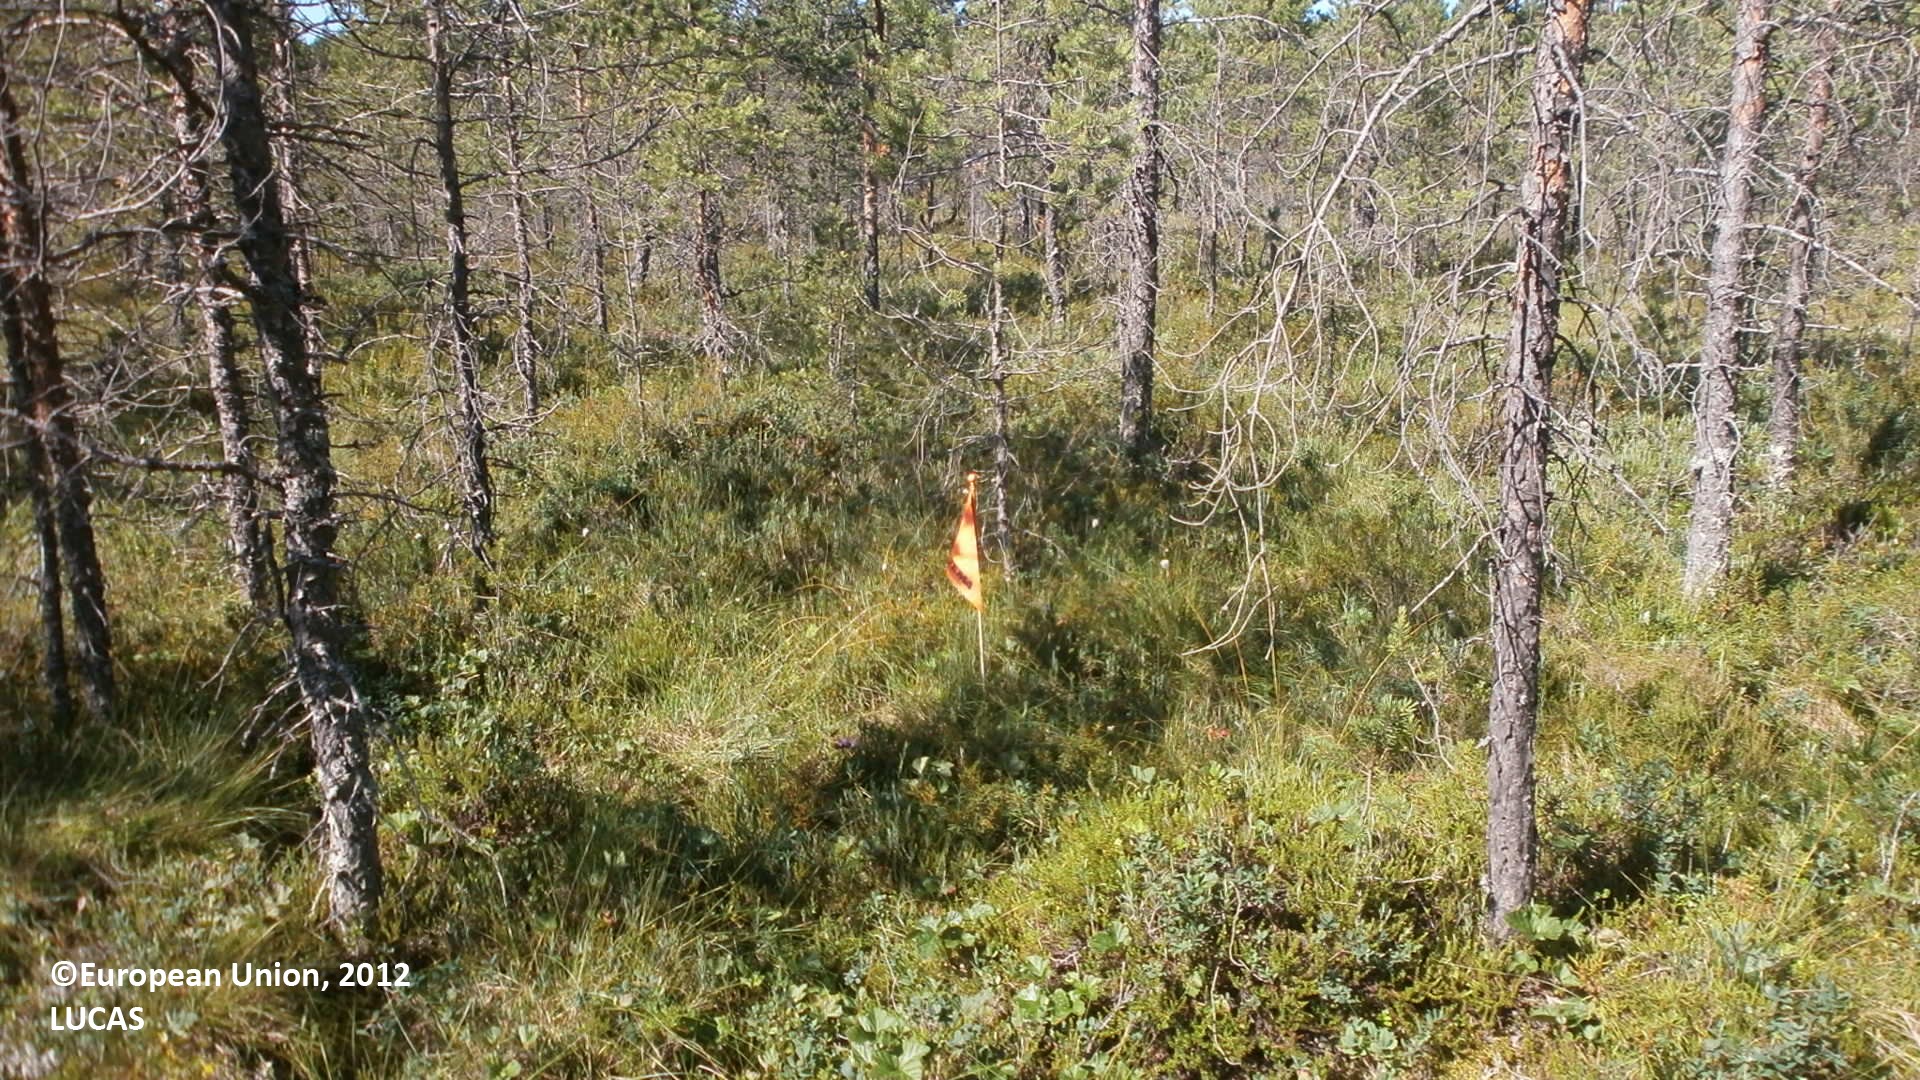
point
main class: Woodland
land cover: Pine dominated coniferous woodland
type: mire and swamp forests
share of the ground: 25 - 50 %
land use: Forestry
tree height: > 5 m
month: July
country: FI
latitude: 64.1720
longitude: 23.8653
